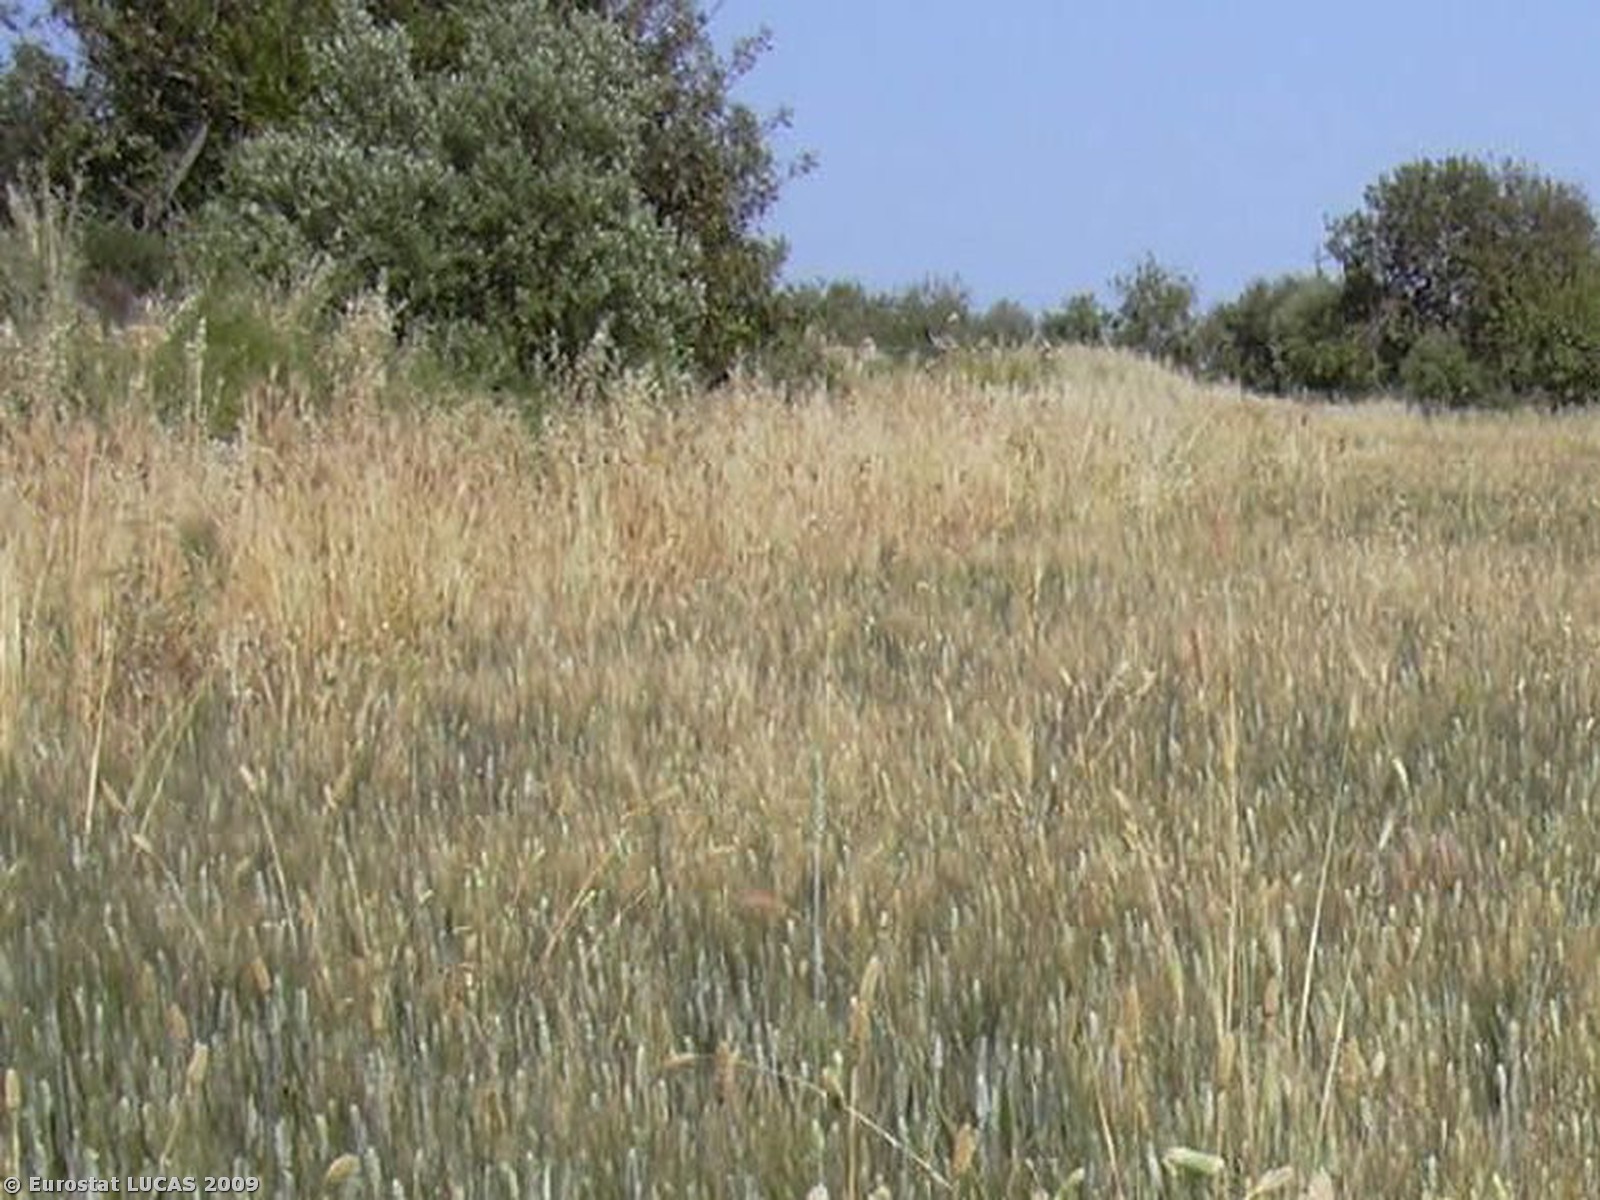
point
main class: Cropland
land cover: Durum wheat
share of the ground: > 75 %
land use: Agriculture (excluding fallow land and kitchen gardens)
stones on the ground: < 10 %
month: May
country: IT
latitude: 36.8036
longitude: 14.8812
